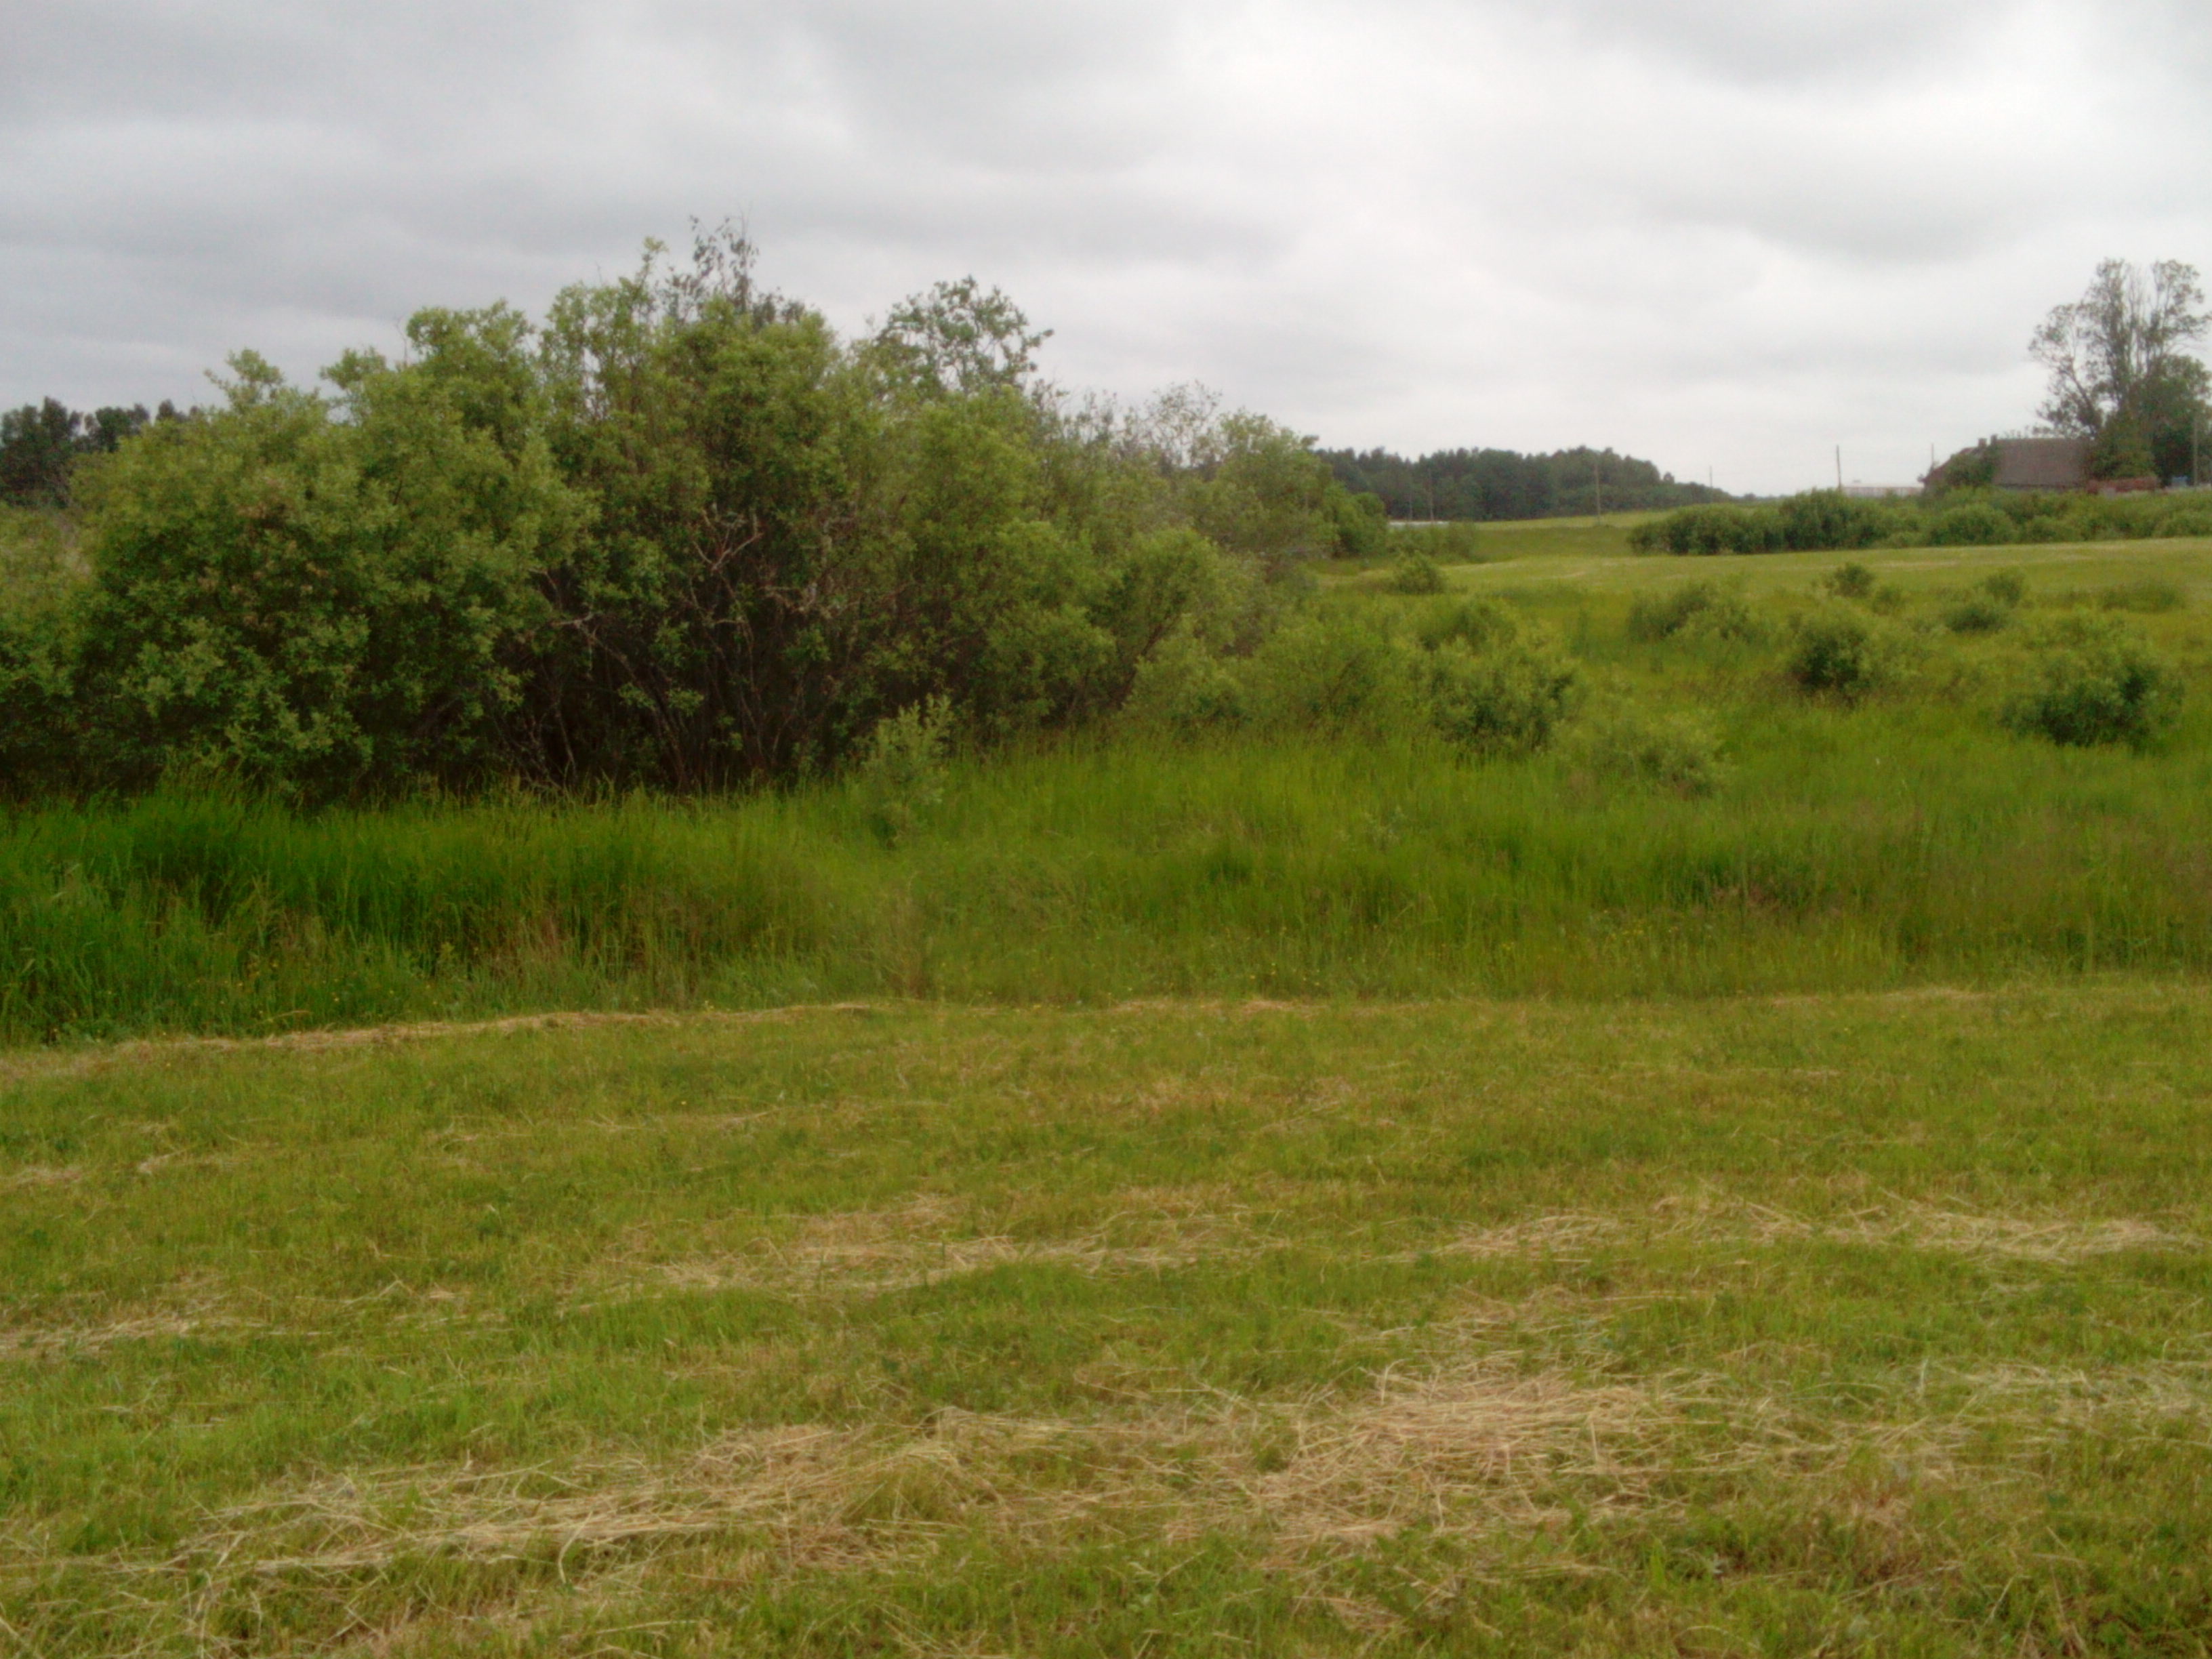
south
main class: Grassland
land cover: Grassland without tree/shrub cover
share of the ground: > 75 %
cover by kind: herbaceous plants 100 %
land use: Agriculture (excluding fallow land and kitchen gardens)
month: June
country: LV
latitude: 56.8419
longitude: 21.9986
